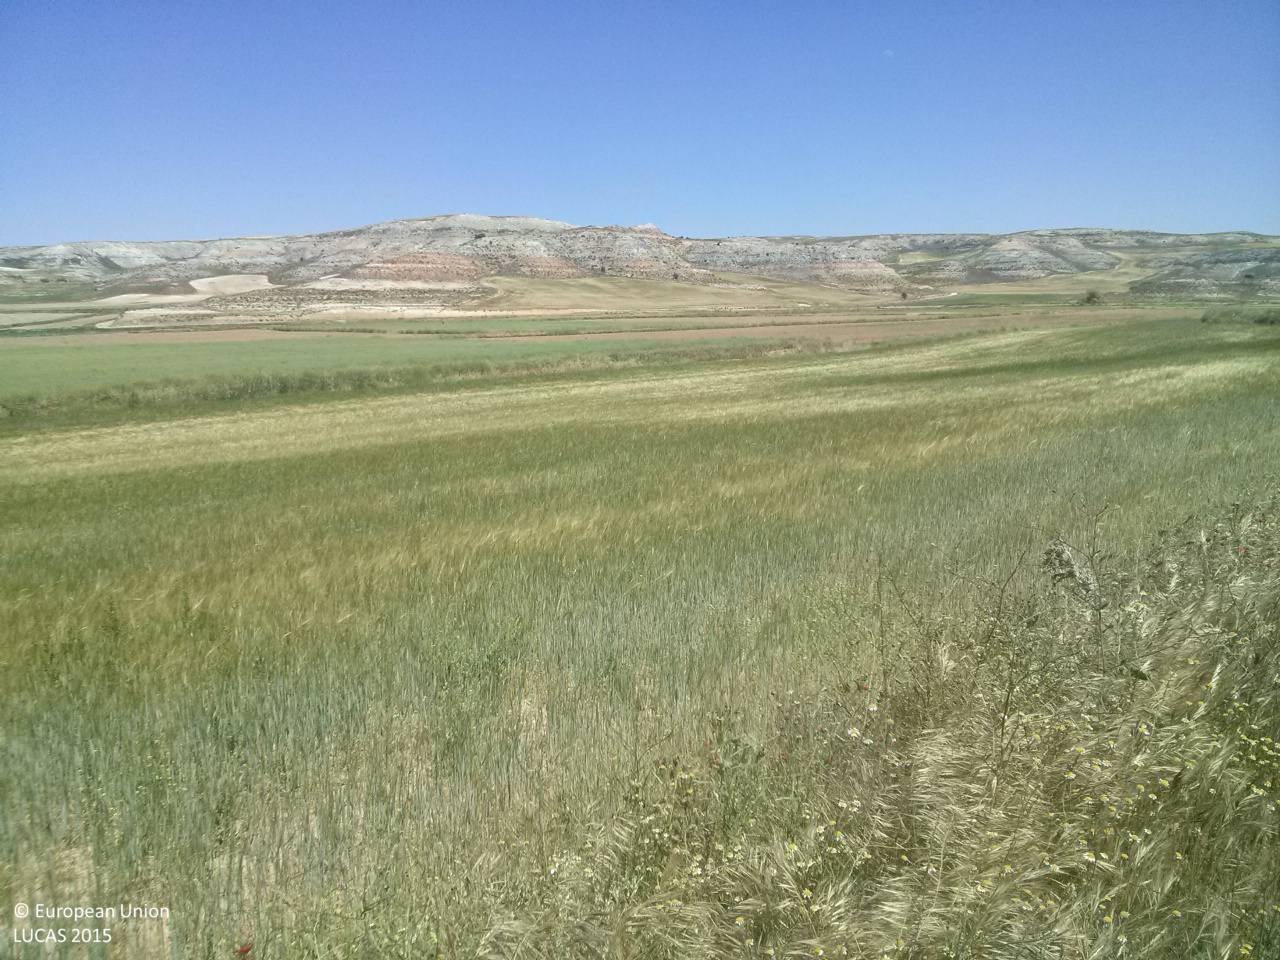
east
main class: Cropland
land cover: Barley
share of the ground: > 75 %
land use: Agriculture (excluding fallow land and kitchen gardens)
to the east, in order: Grass margins; Barley; Grass margins; Rivers and streams; Grass margins; Barley; Sunflower
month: May
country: ES
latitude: 40.2929
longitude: -2.5983
